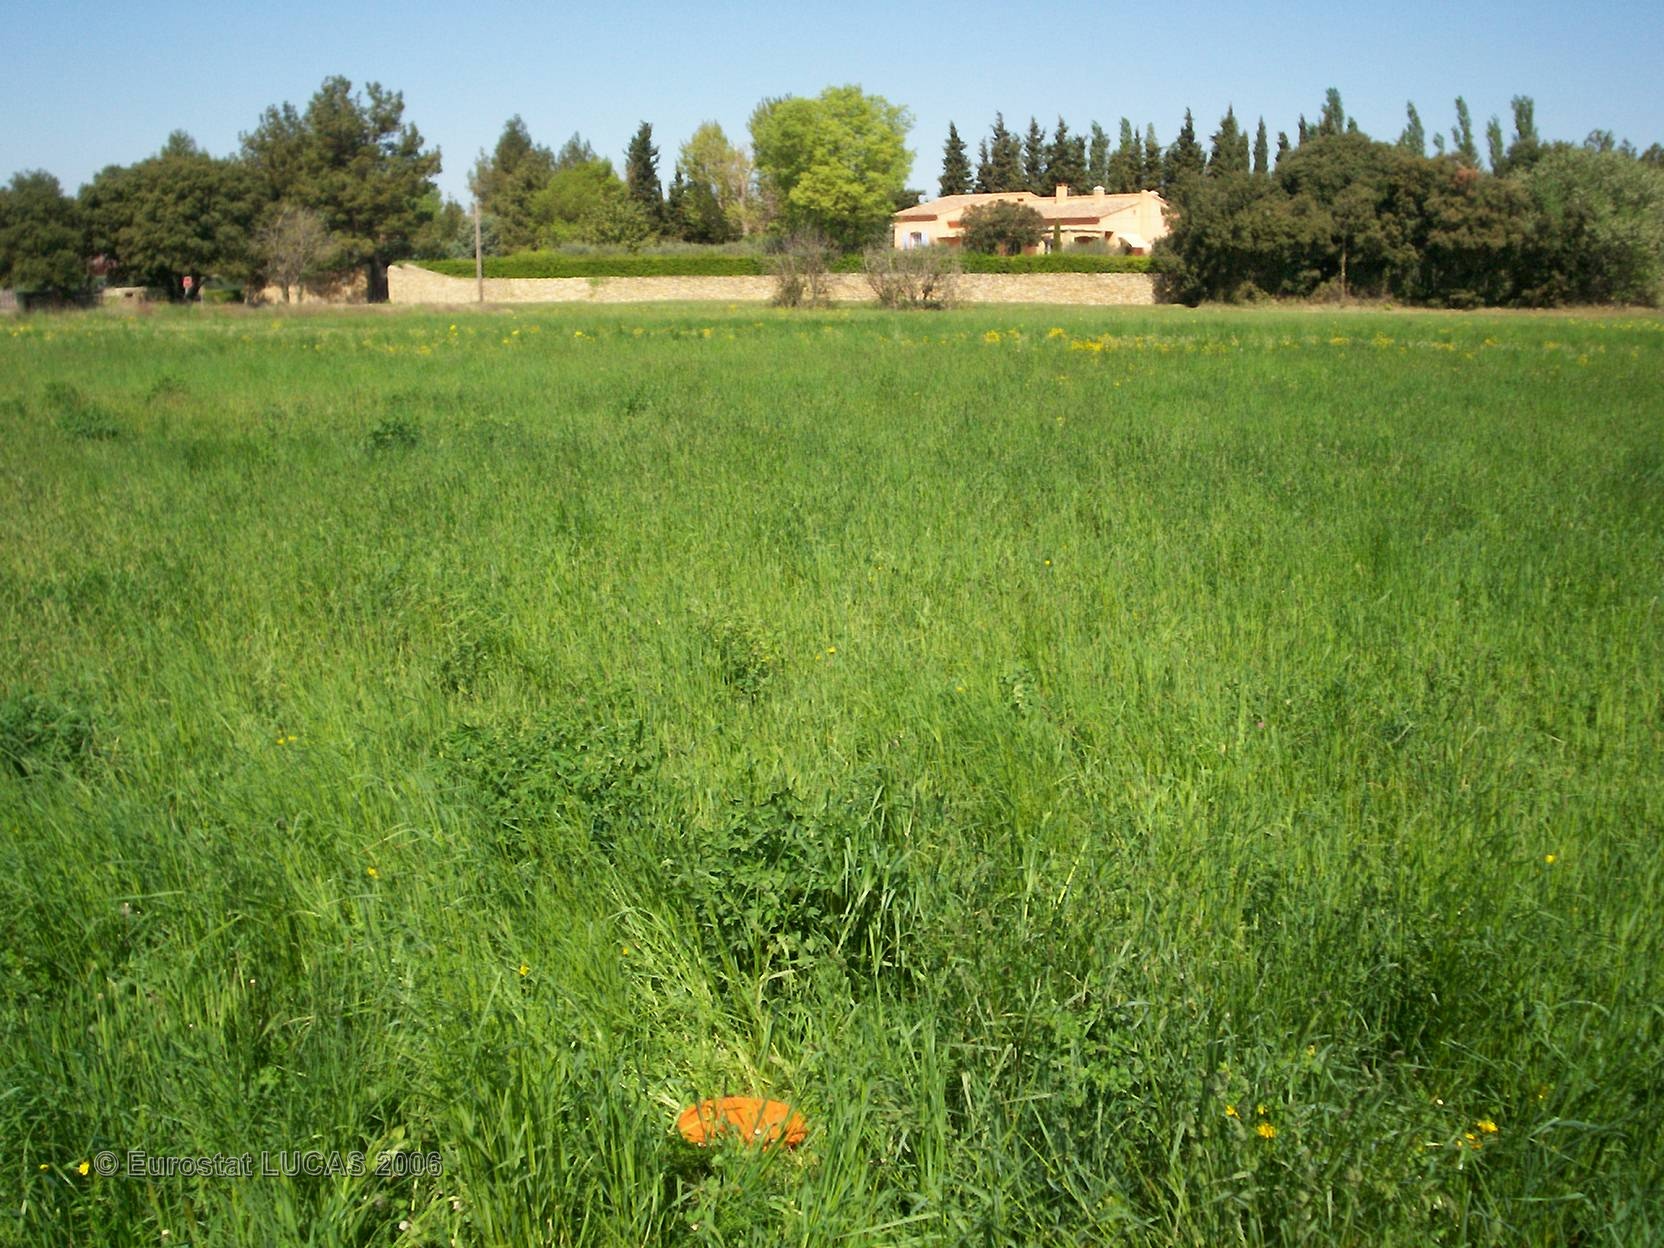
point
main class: Grassland
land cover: Grassland without tree/shrub cover
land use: Agriculture (excluding fallow land and kitchen gardens)
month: April
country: FR
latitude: 43.5839
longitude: 5.0930
